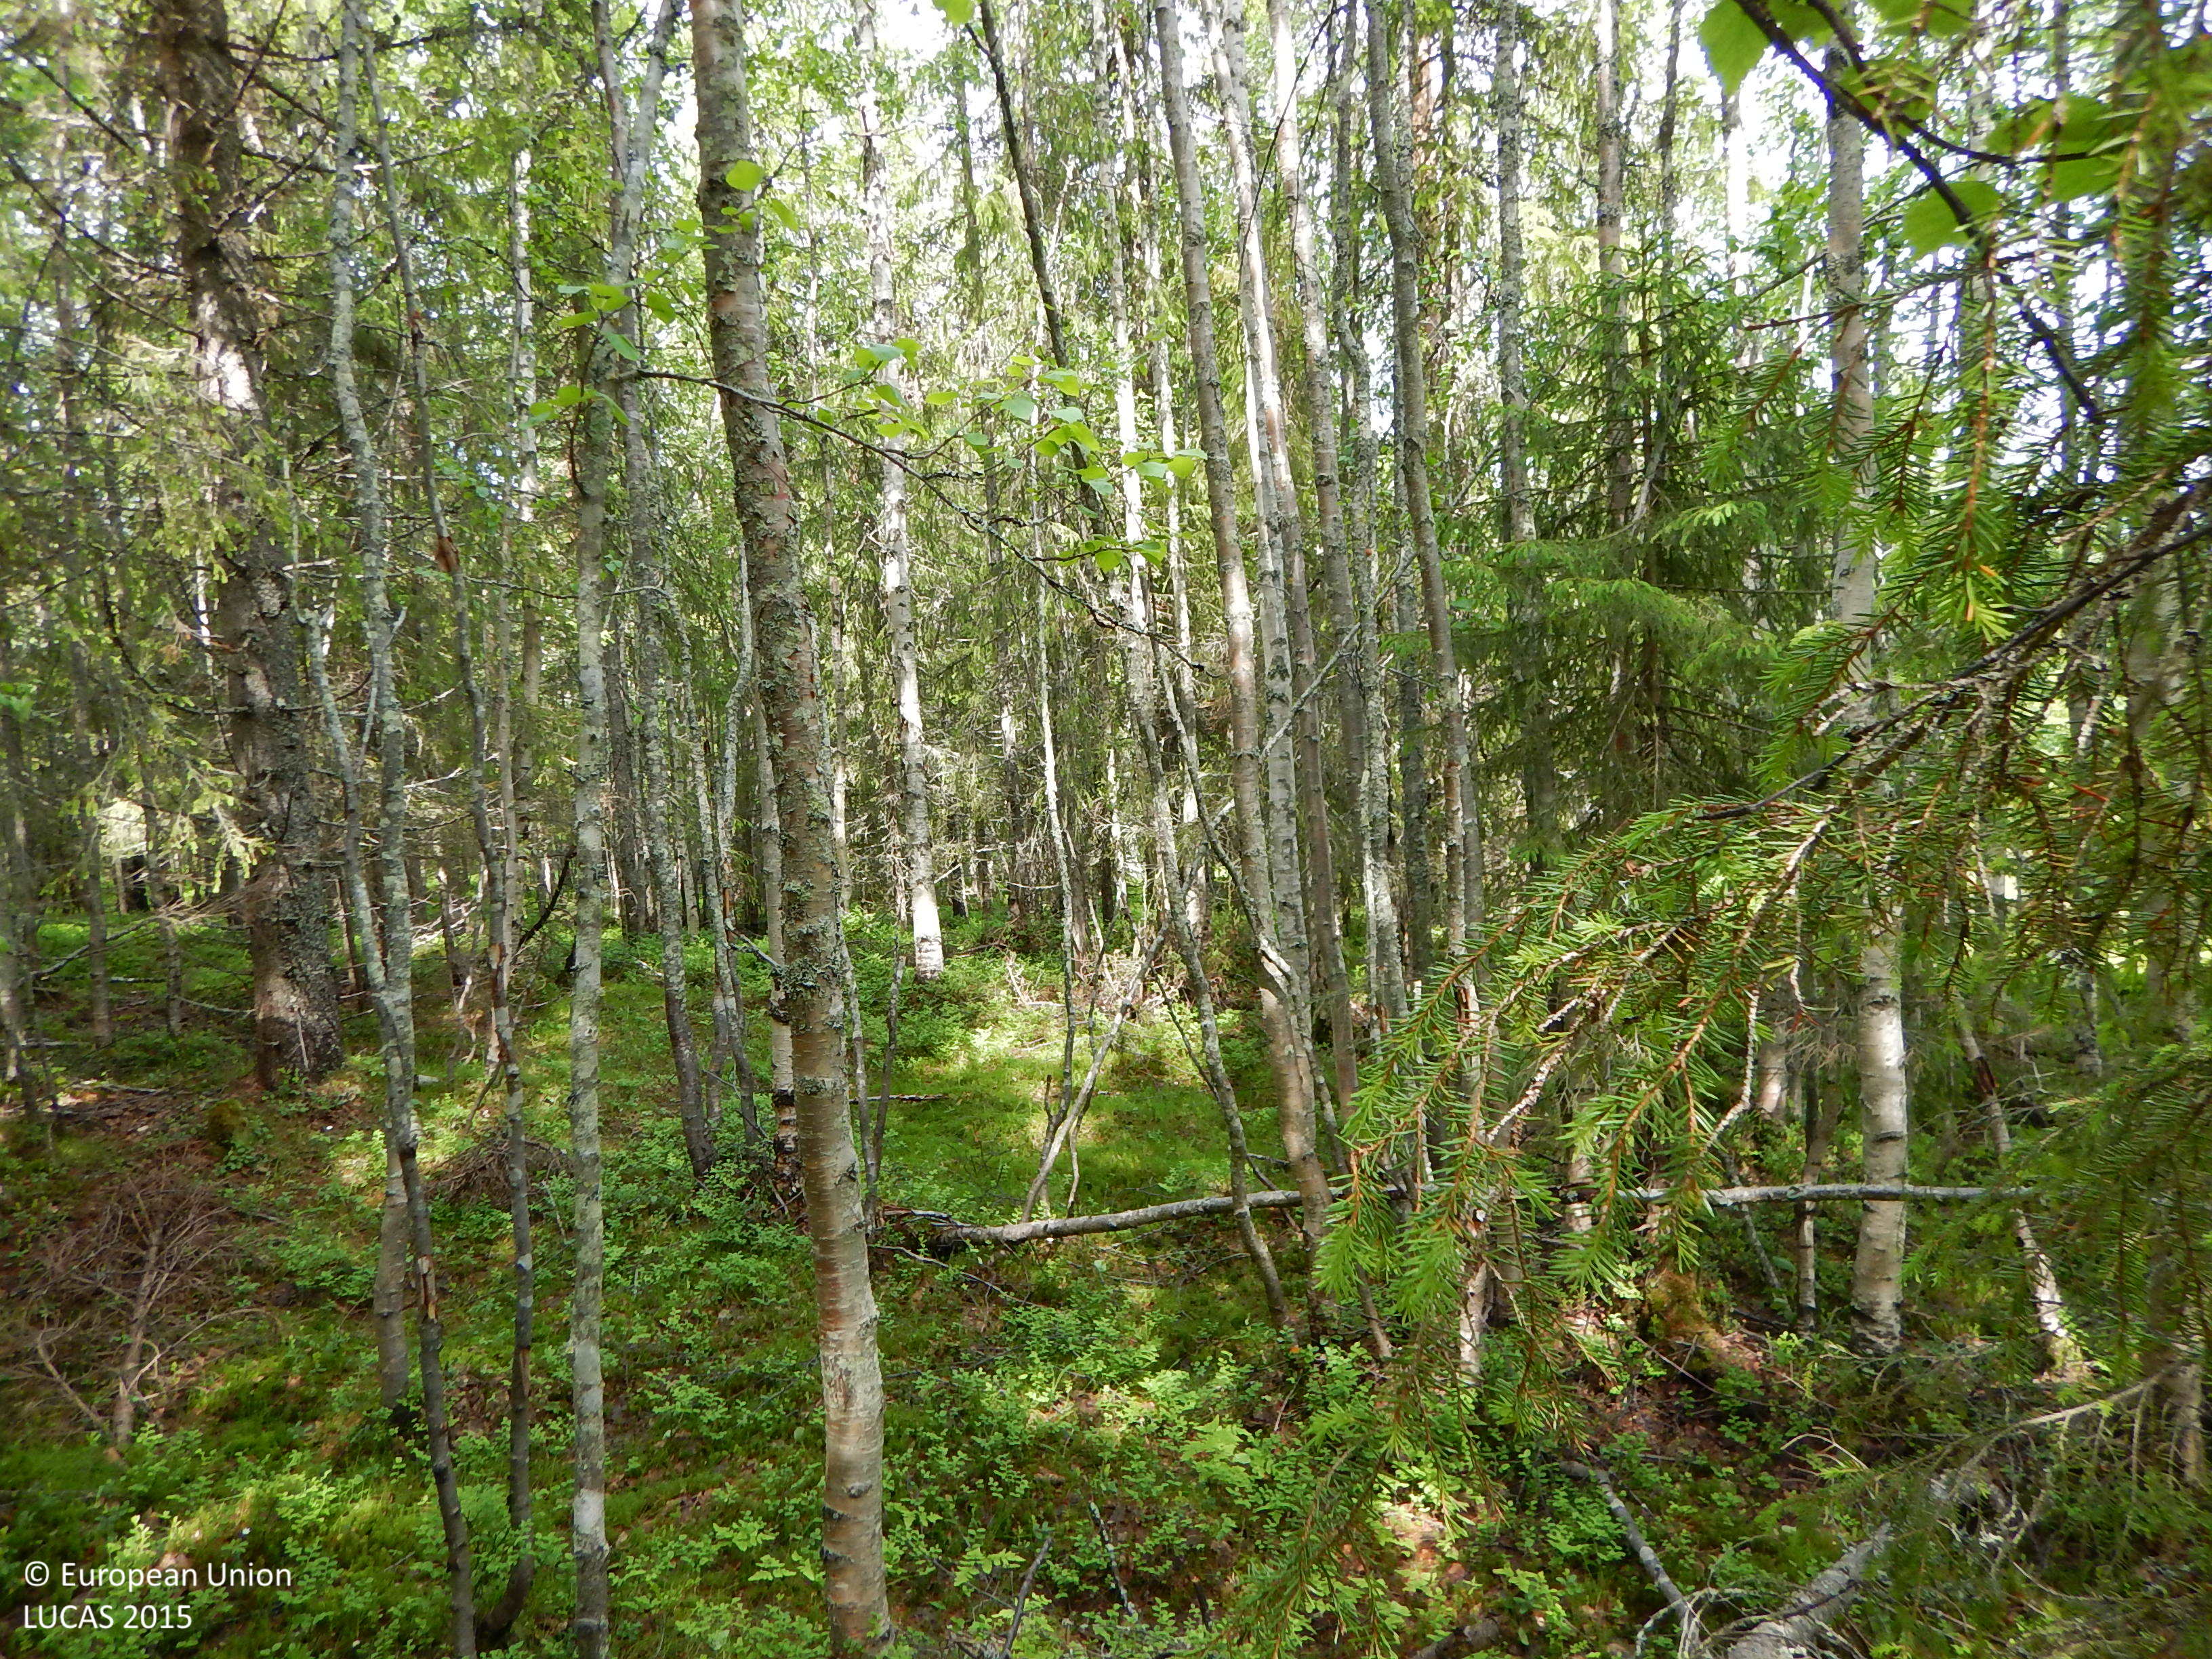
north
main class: Woodland
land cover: Other mixed woodland
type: boreal forest
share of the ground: 50 - 75 %
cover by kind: coniferous forest trees 40 %, broadleaved forest trees 30 %, shrubs 15 %, herbaceous plants 10 %, lichens and mosses 5 %
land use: Forestry
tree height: > 5 m
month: July
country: SE
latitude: 65.2205
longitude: 18.9228
